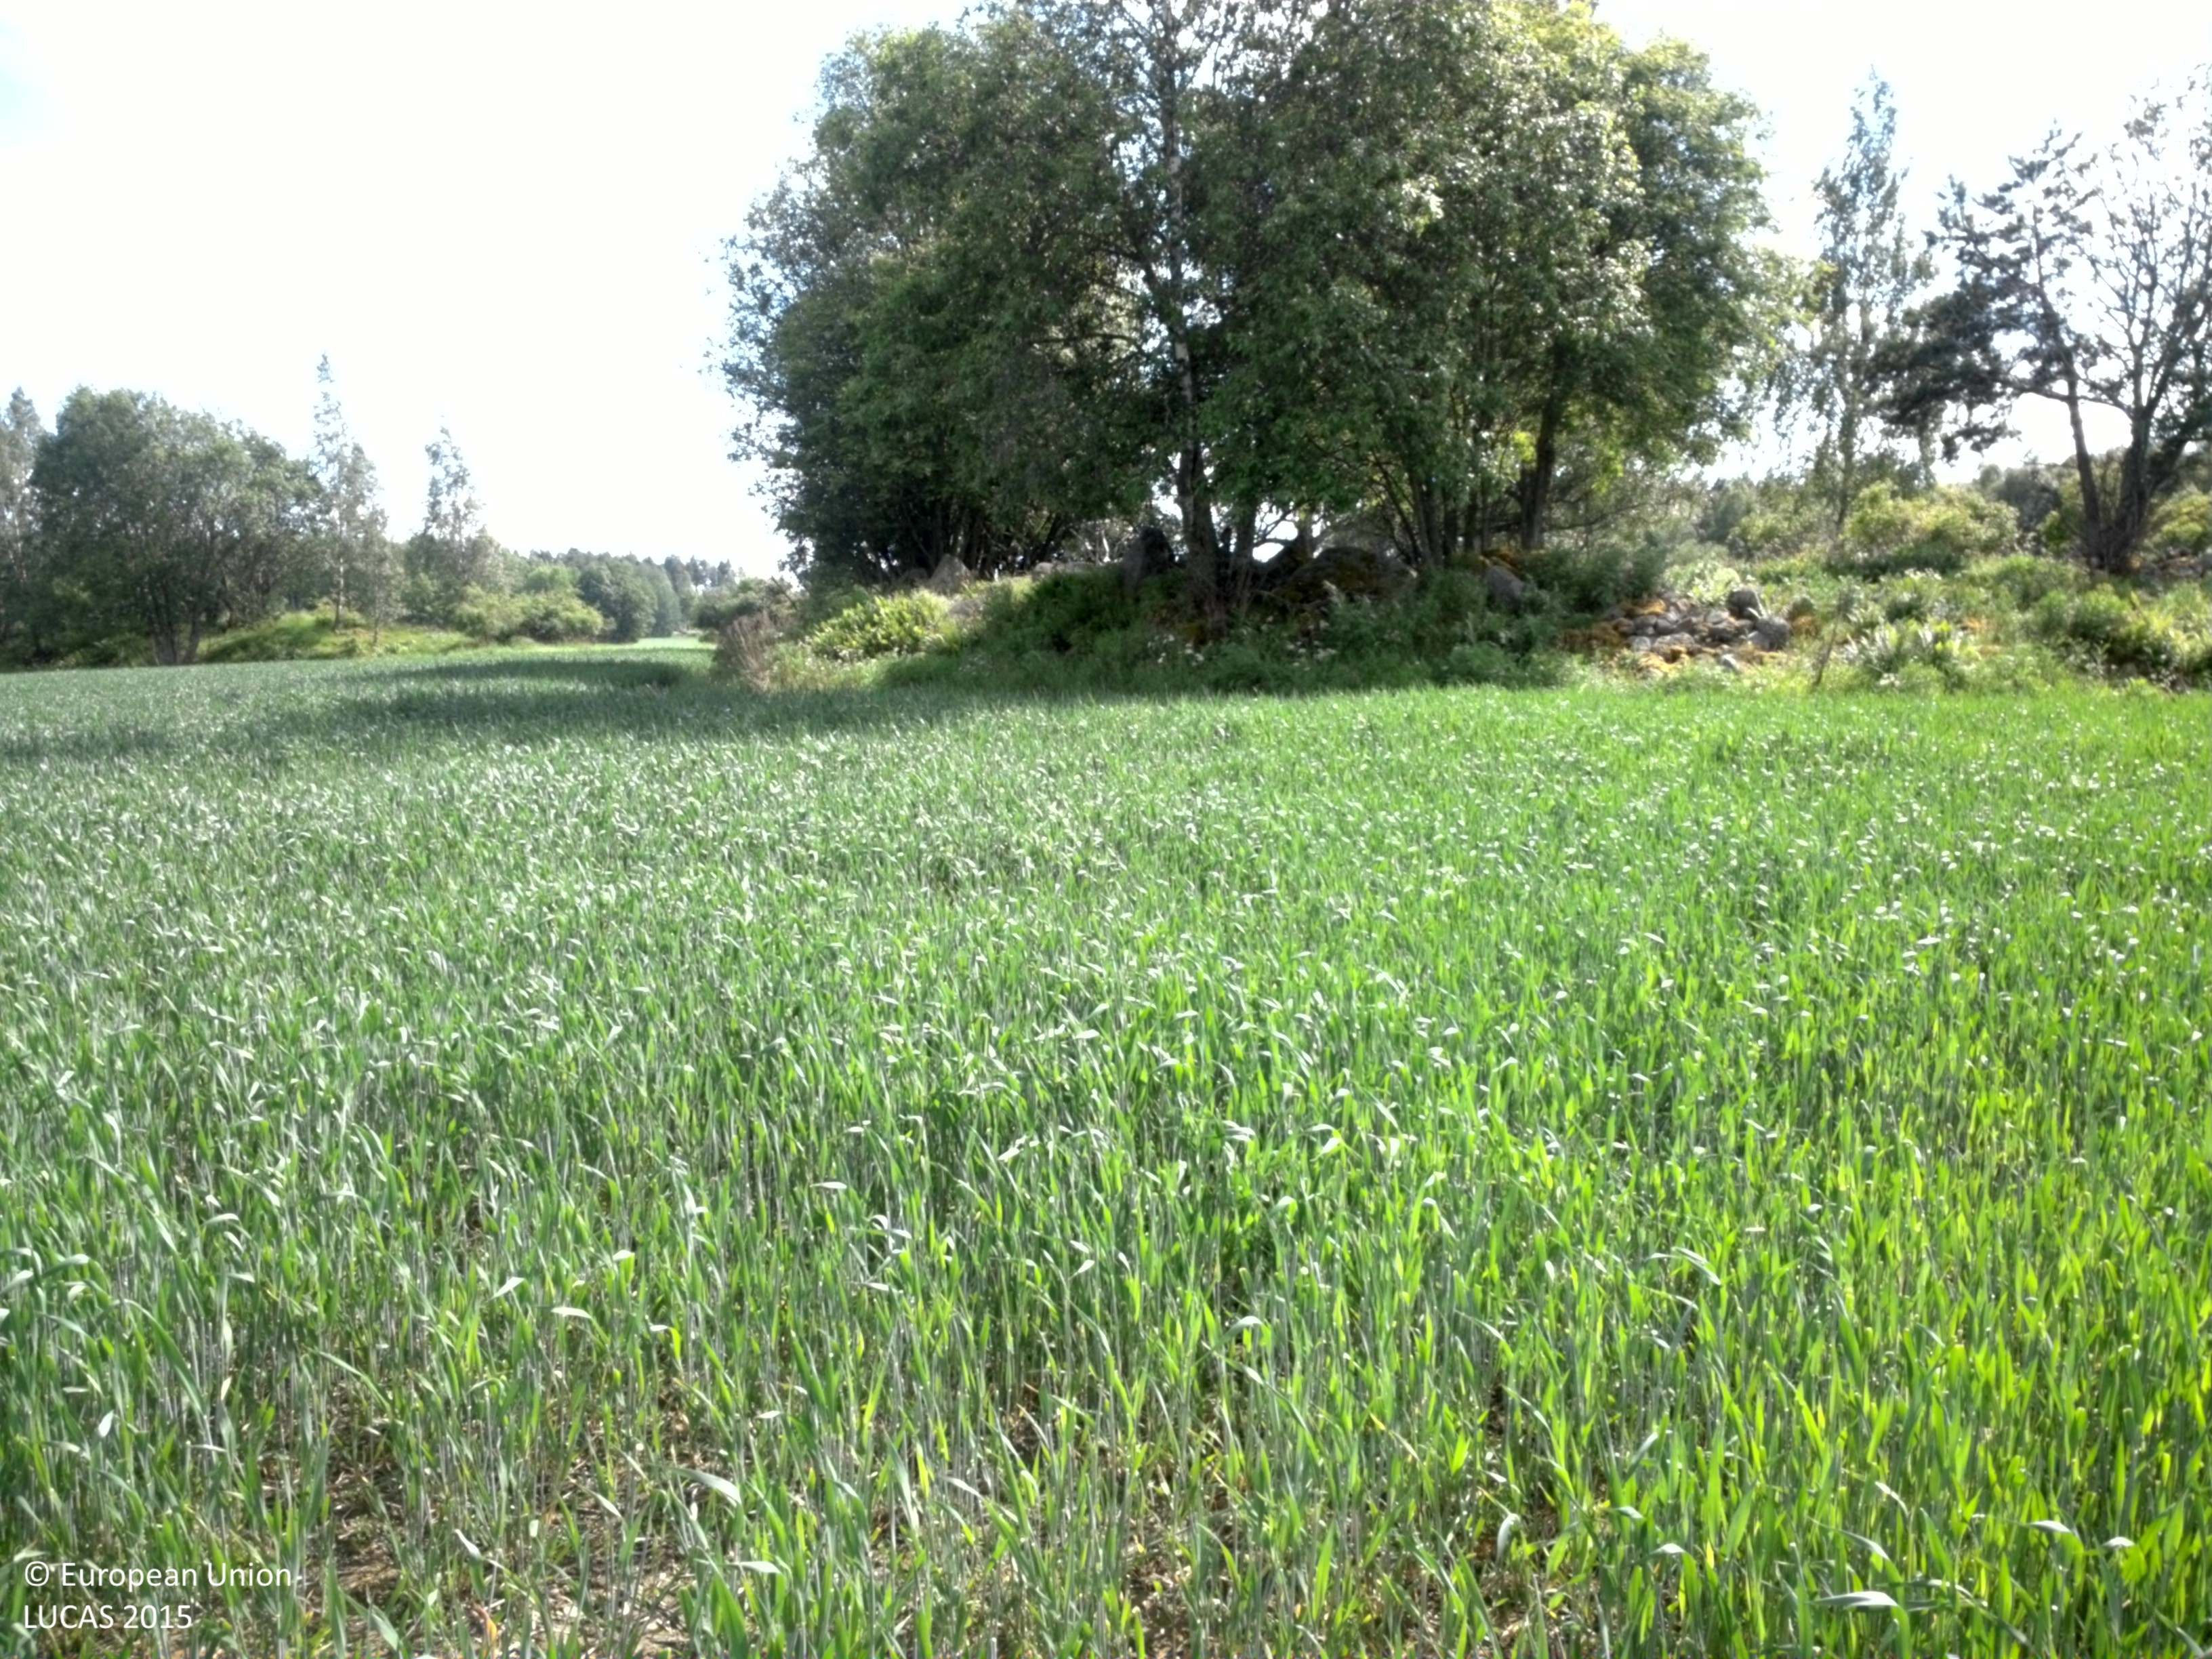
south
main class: Cropland
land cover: Common wheat
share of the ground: > 75 %
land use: Agriculture (excluding fallow land and kitchen gardens)
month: June
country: SE
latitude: 59.5737
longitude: 16.9861
